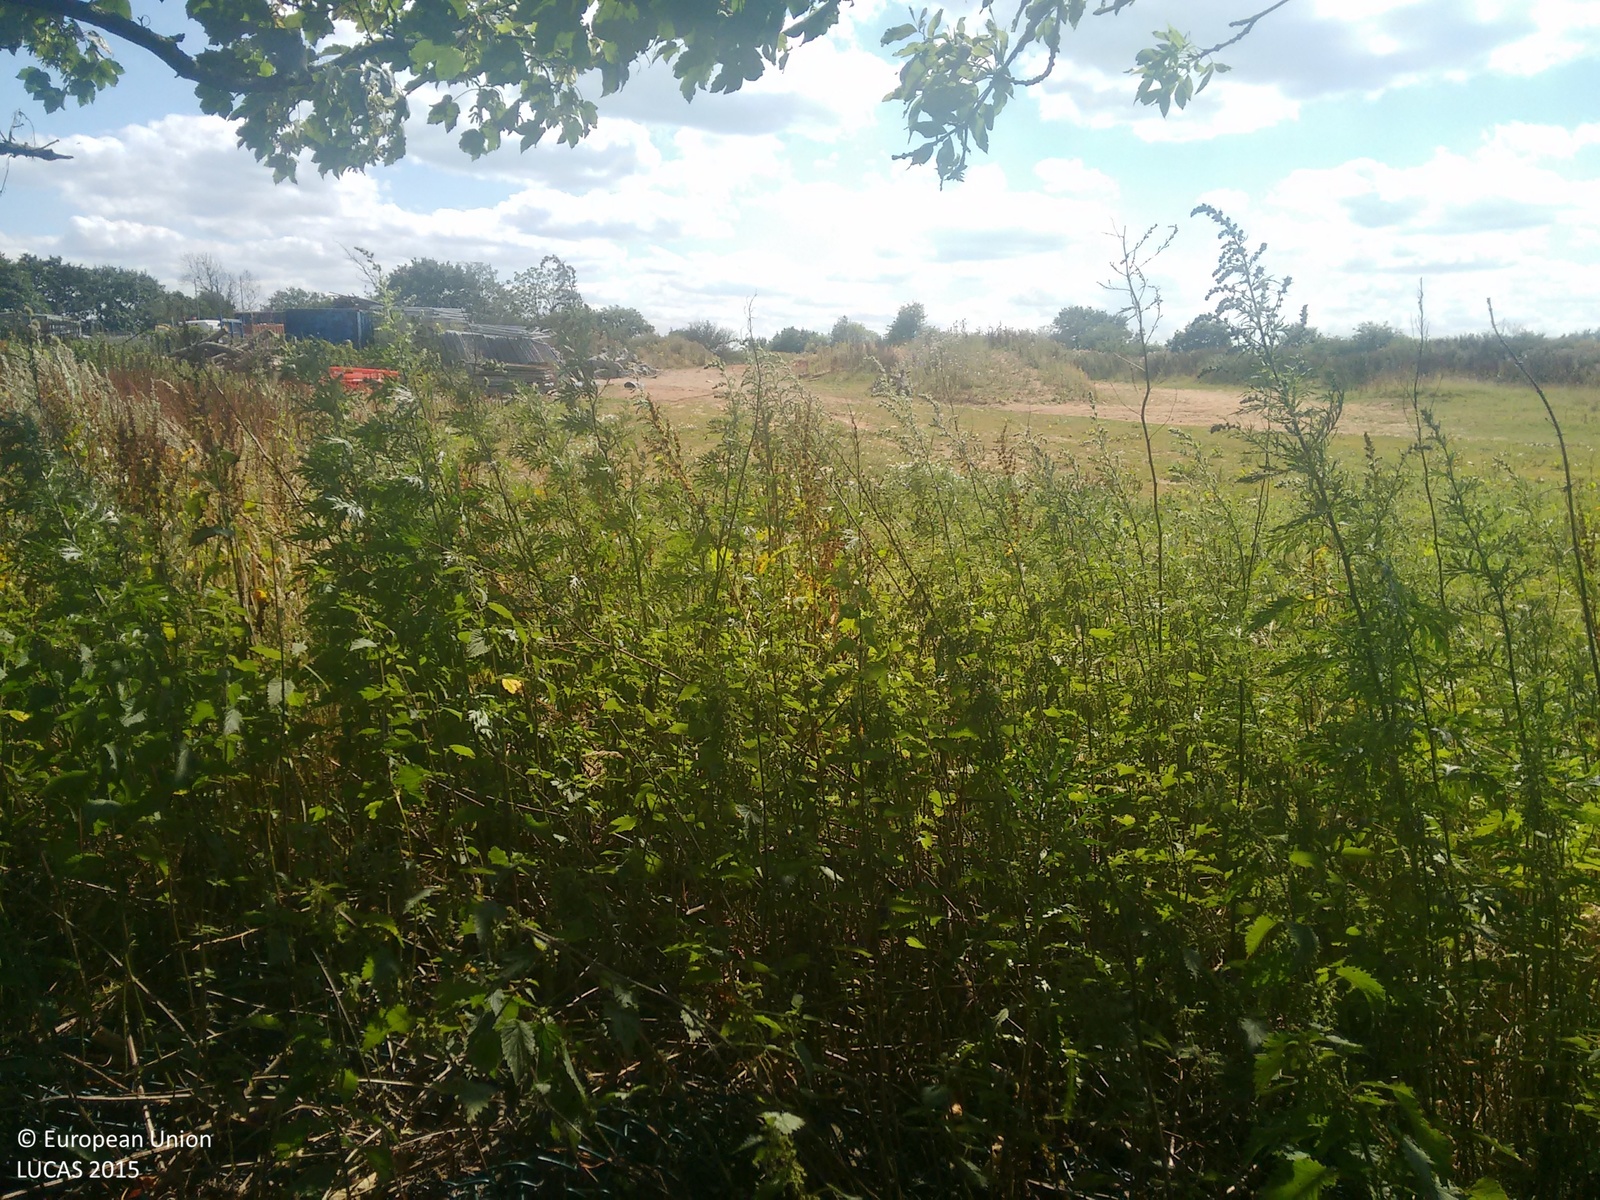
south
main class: Grassland
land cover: Grassland without tree/shrub cover
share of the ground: > 75 %
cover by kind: herbaceous plants 100 %
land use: Semi-natural and natural areas not in use
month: July
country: GB
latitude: 52.4457
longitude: -1.7511
